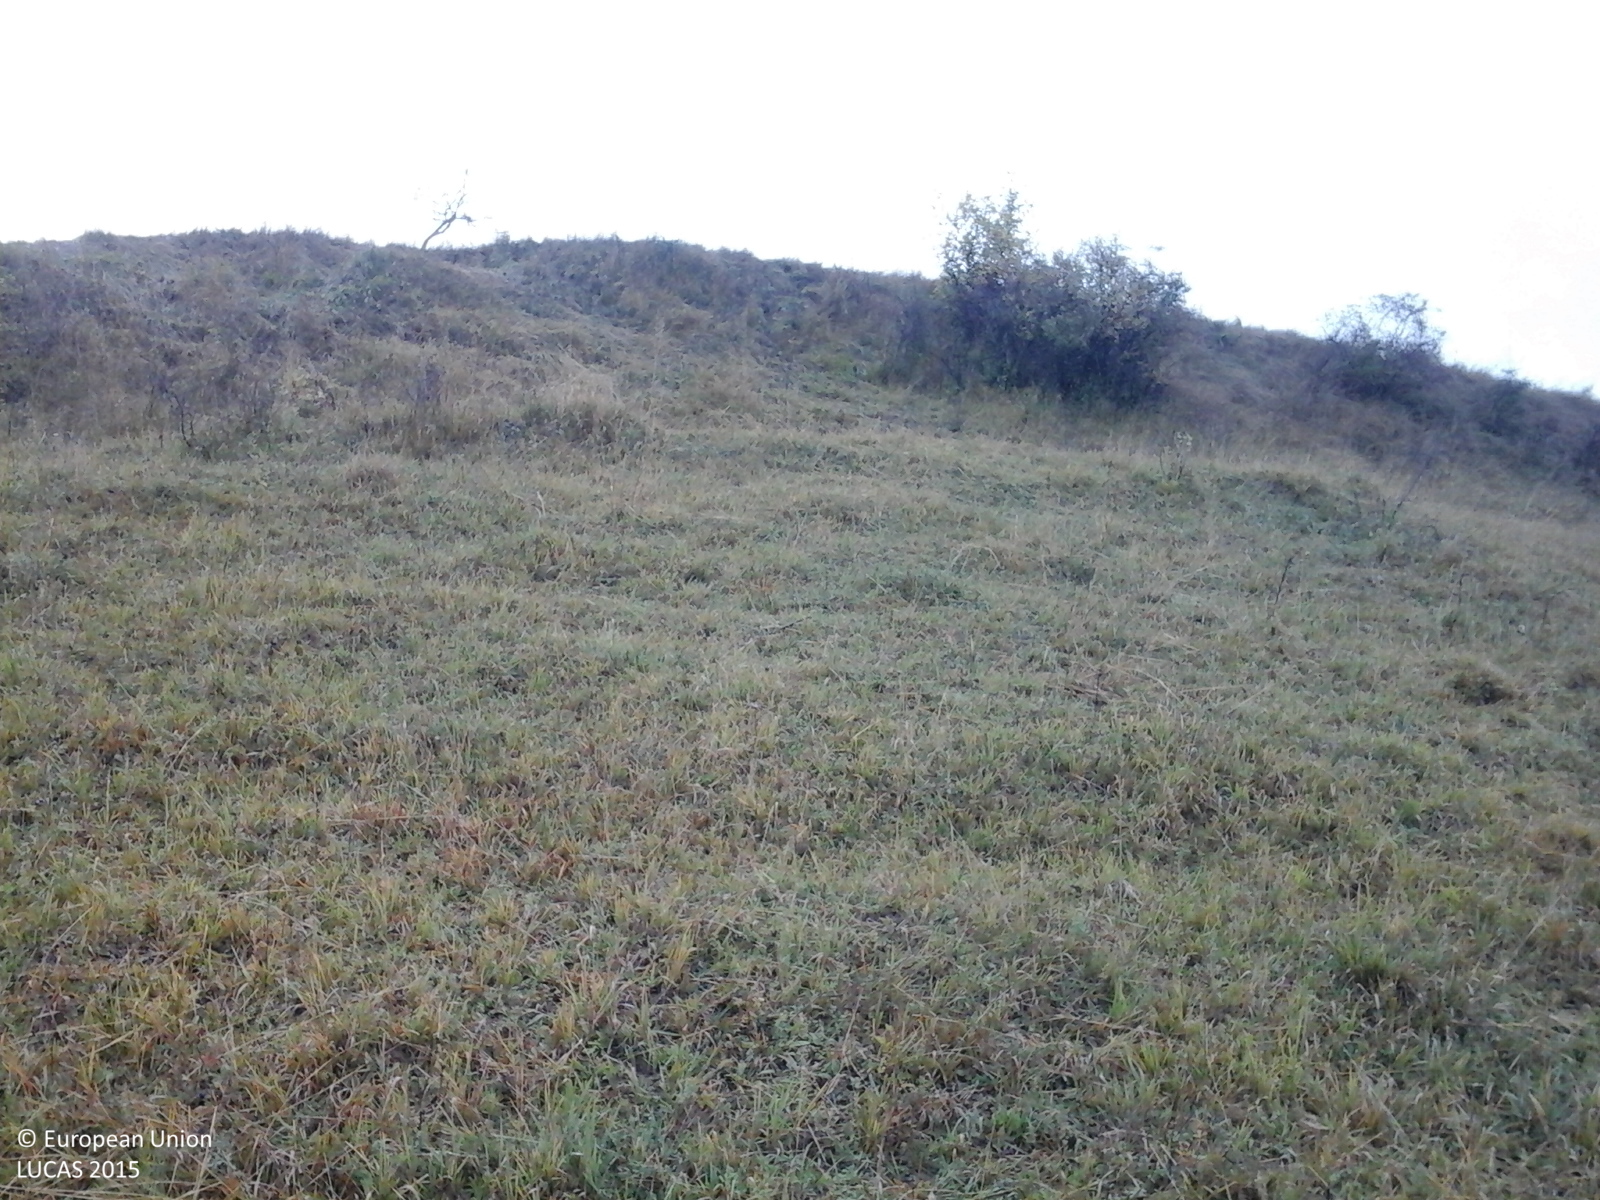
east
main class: Grassland
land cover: Grassland with sparse tree/shrub cover
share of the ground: > 75 %
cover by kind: herbaceous plants 95 %, broadleaved forest trees 5 %
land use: Agriculture (excluding fallow land and kitchen gardens)
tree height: > 5 m
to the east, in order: Grassland with sparse tree/shrub cover; Apple fruit; Shrubland with sparse tree cover; Apple fruit; Tracks; Apple fruit
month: October
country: RO
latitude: 46.1053
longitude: 24.6410
